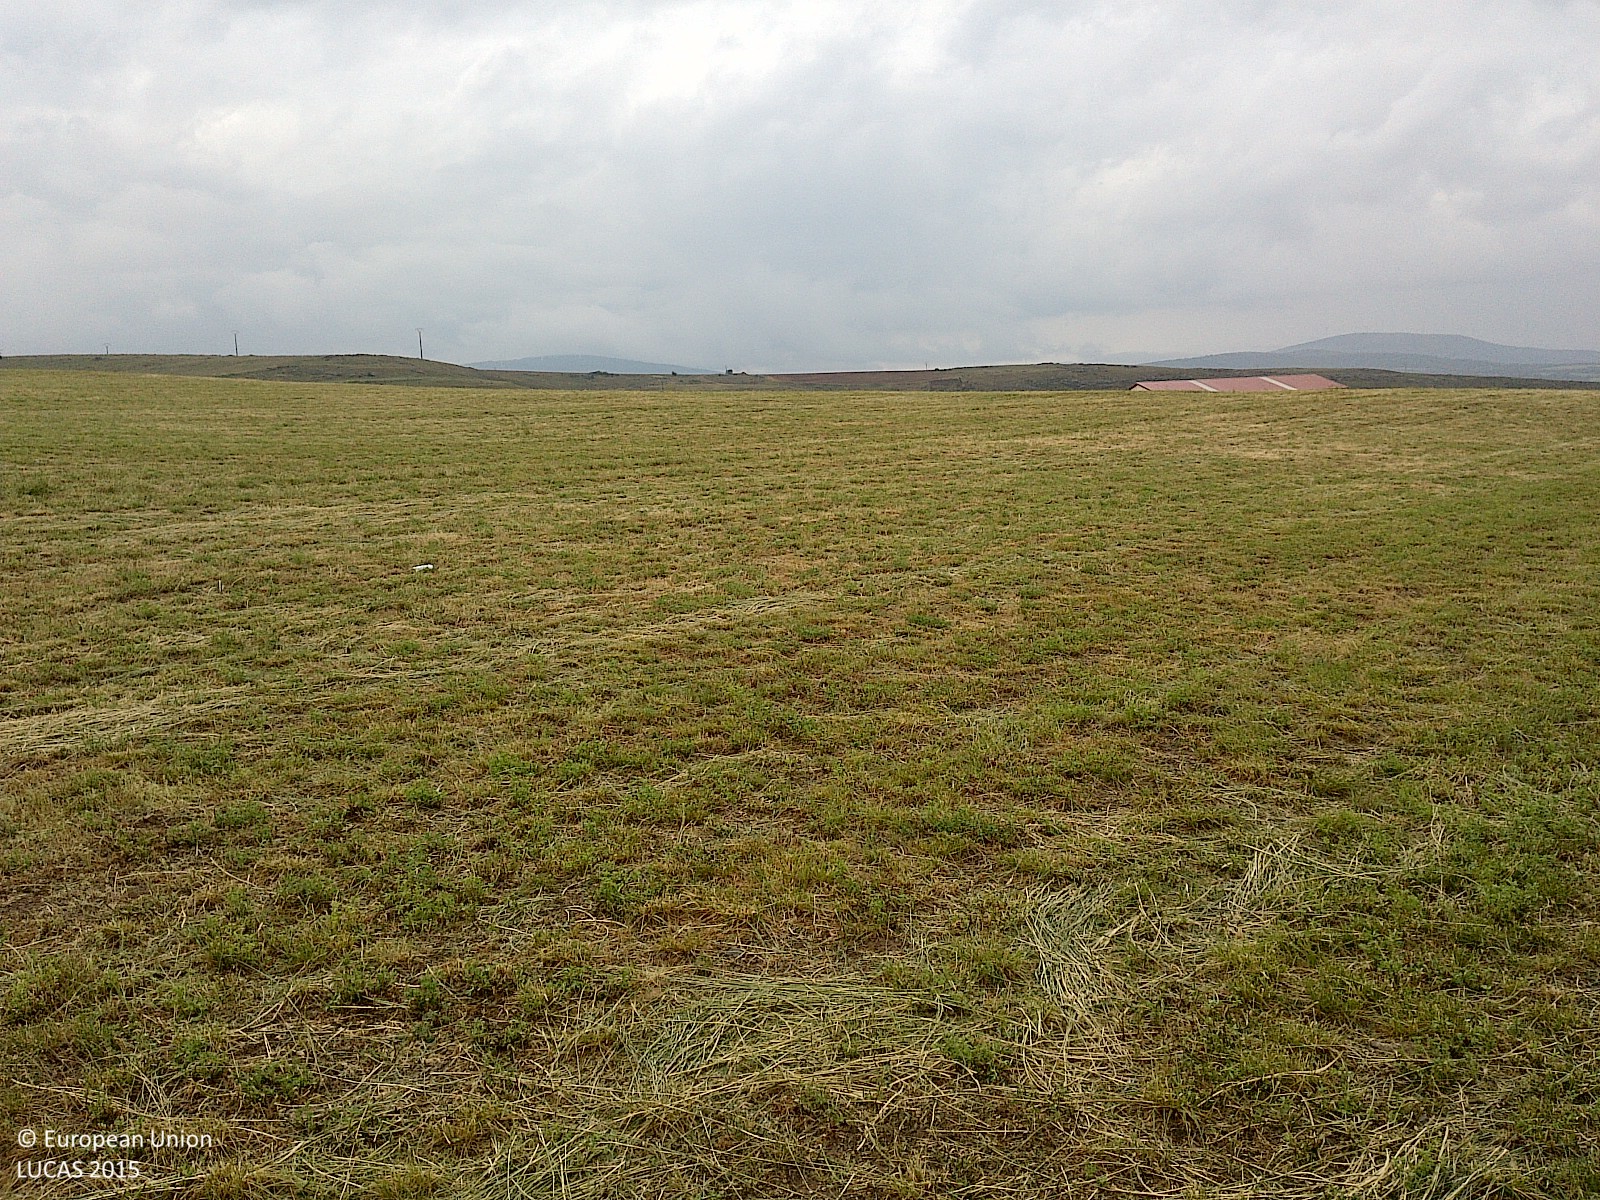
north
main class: Cropland
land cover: Lucerne
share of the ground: > 75 %
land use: Agriculture (excluding fallow land and kitchen gardens)
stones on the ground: < 10 %
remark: Harvested field
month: May
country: ES
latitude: 41.7622
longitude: -2.2440
